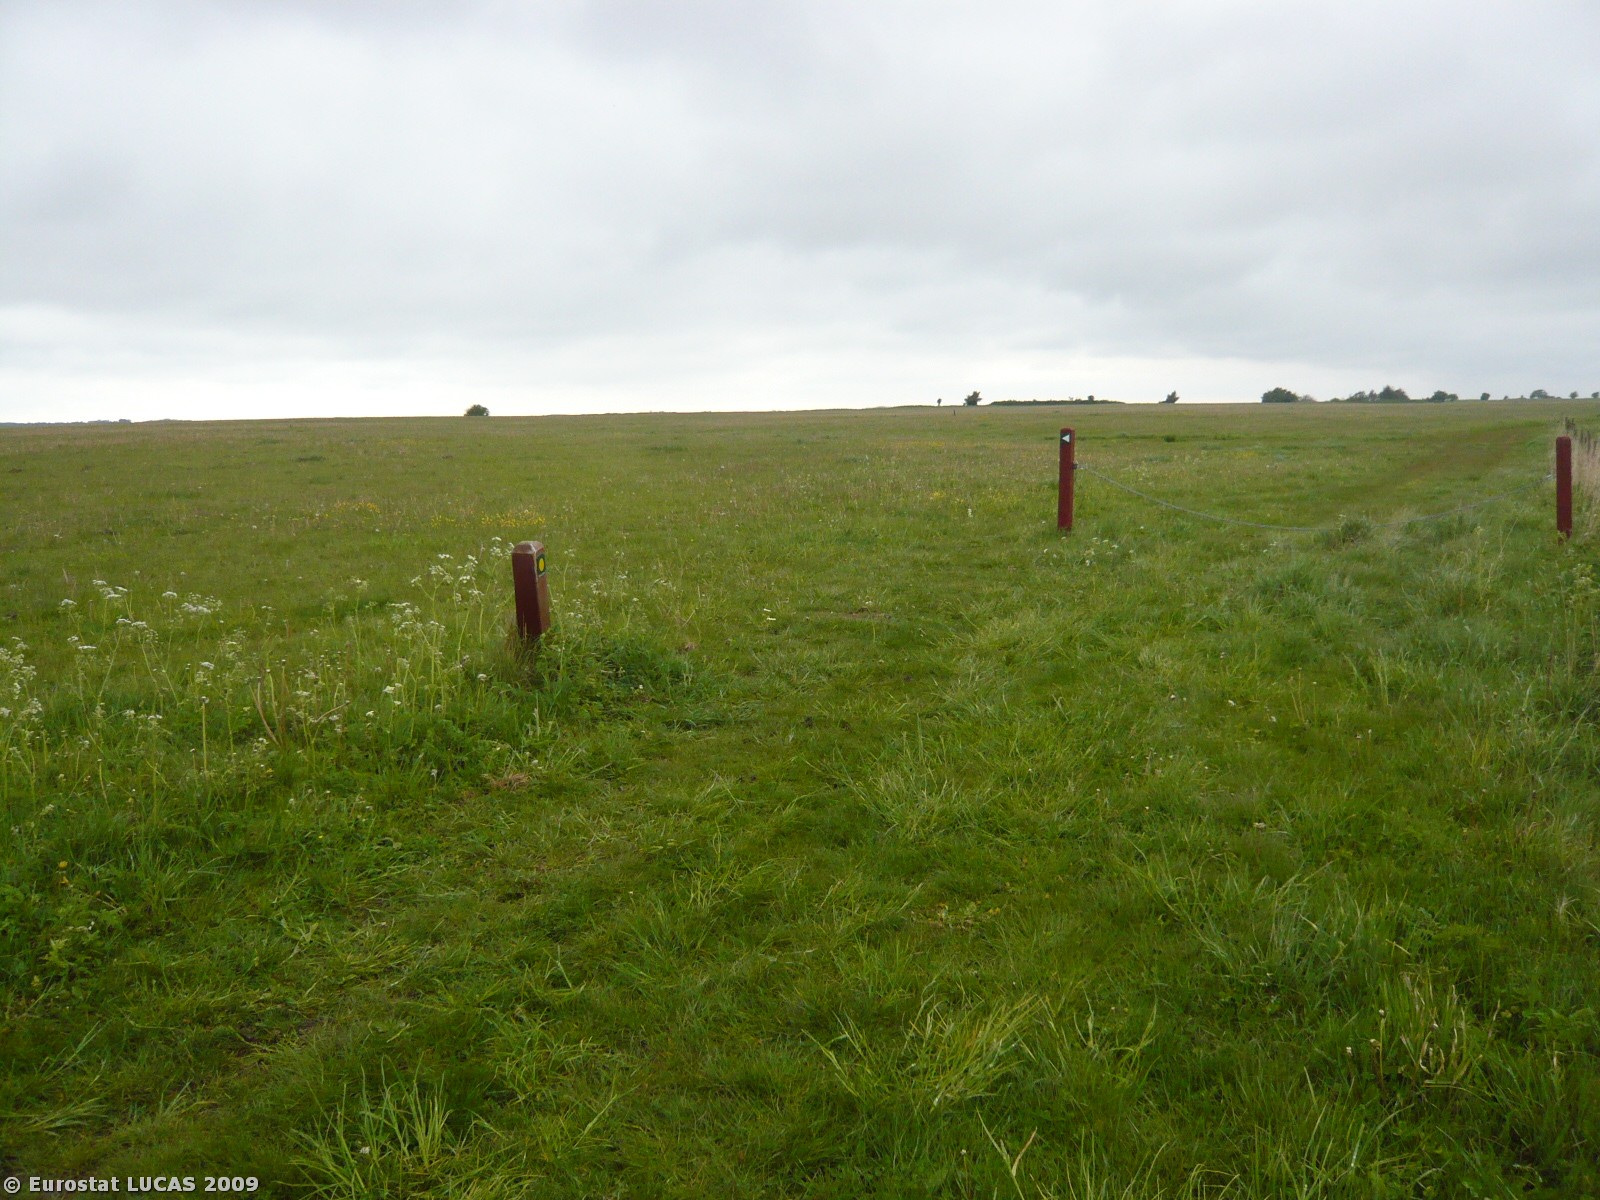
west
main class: Grassland
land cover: Grassland without tree/shrub cover
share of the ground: > 75 %
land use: Agriculture (excluding fallow land and kitchen gardens)
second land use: Nature reserves
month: May
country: DK
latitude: 55.0789
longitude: 11.7687
